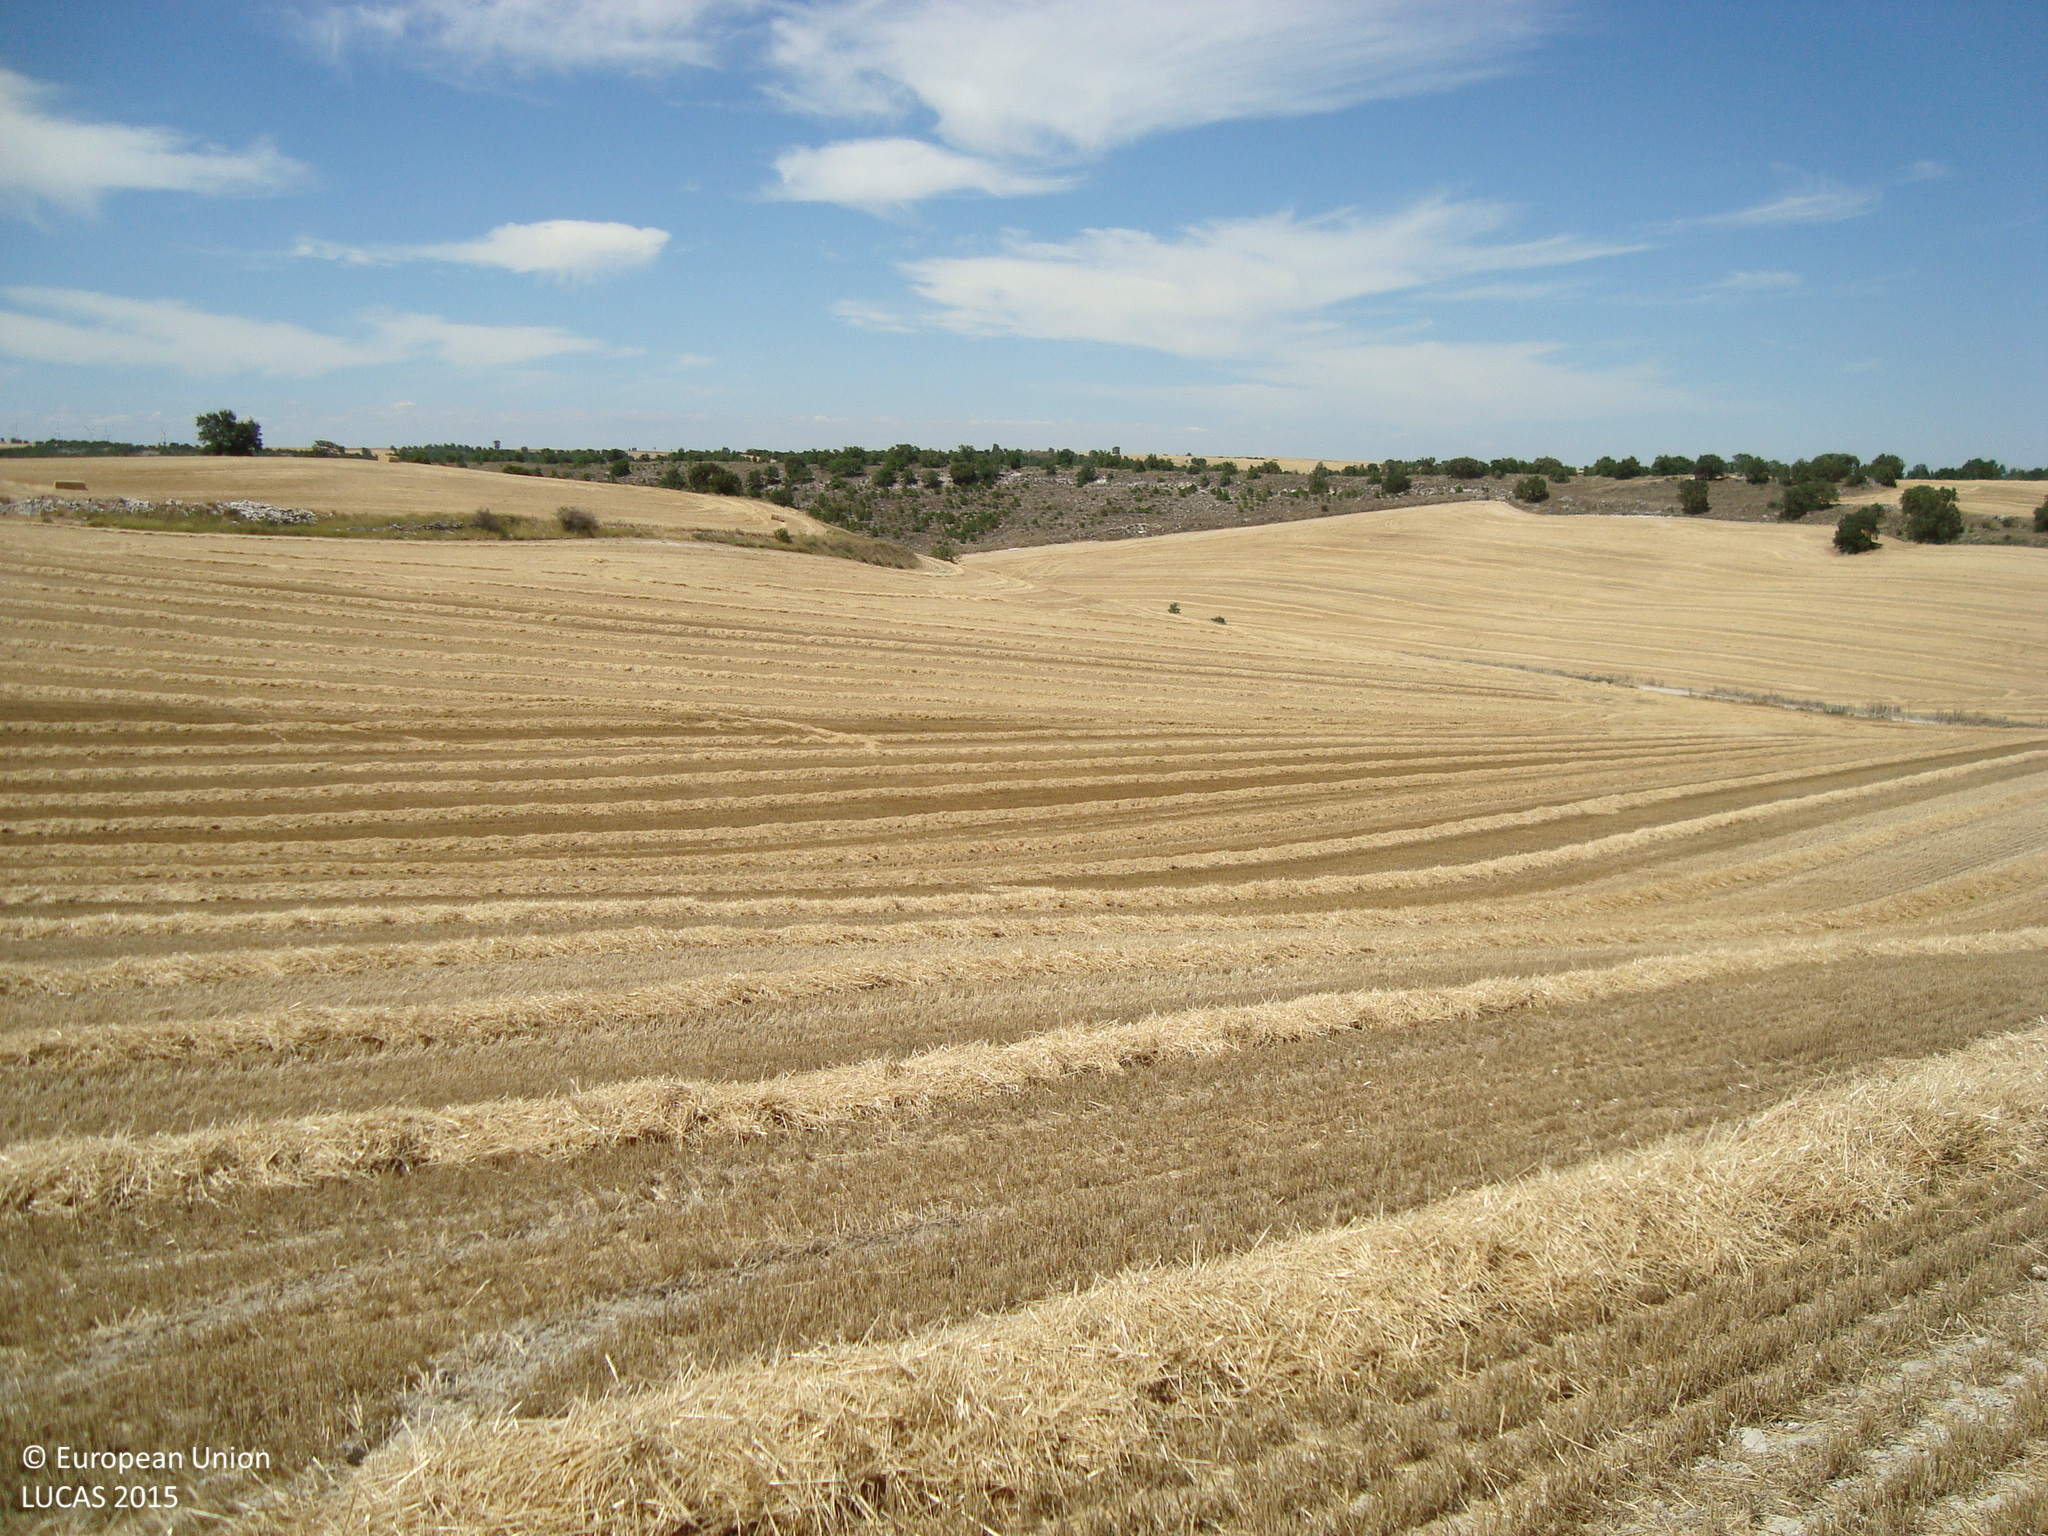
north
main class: Cropland
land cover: Common wheat
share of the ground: > 75 %
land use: Agriculture (excluding fallow land and kitchen gardens)
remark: Harvested field
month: July
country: ES
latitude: 41.9846
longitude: -4.1491
